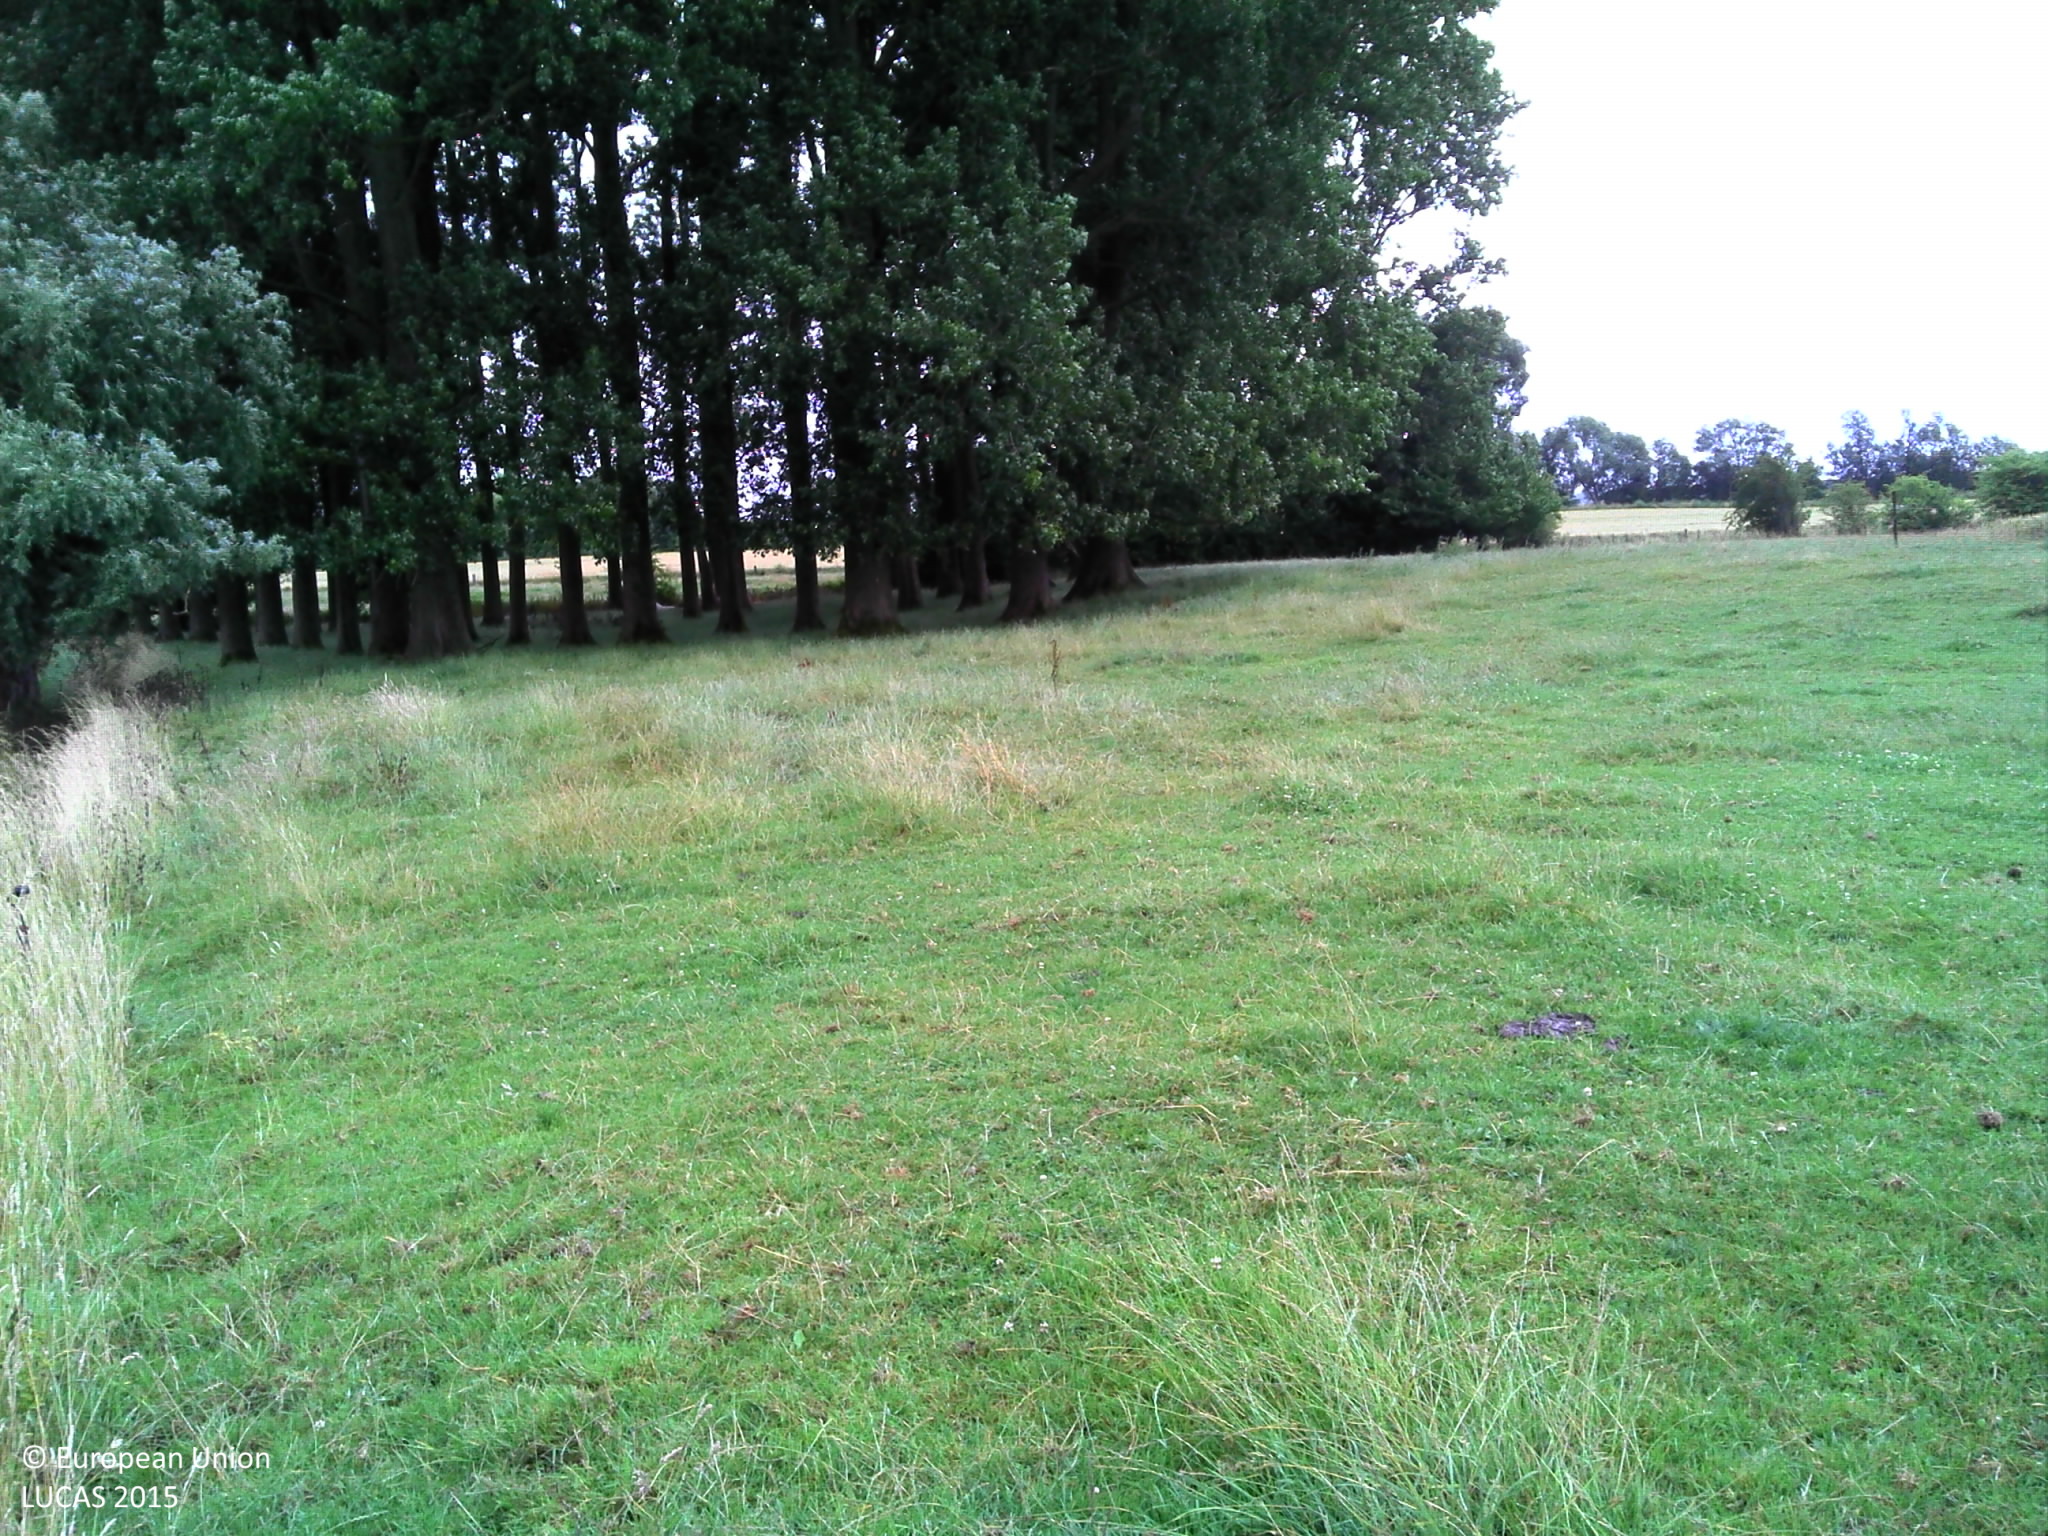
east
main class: Grassland
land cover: Grassland without tree/shrub cover
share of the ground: > 75 %
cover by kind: herbaceous plants 100 %
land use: Agriculture (excluding fallow land and kitchen gardens)
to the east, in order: Fences; Grassland without tree/shrub cover; Broadleaved woodland; Fences; Ditches and canals; Fences; Grassland without tree/shrub cover; Fences; Common wheat
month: July
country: BE
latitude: 50.3563
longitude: 4.1053
